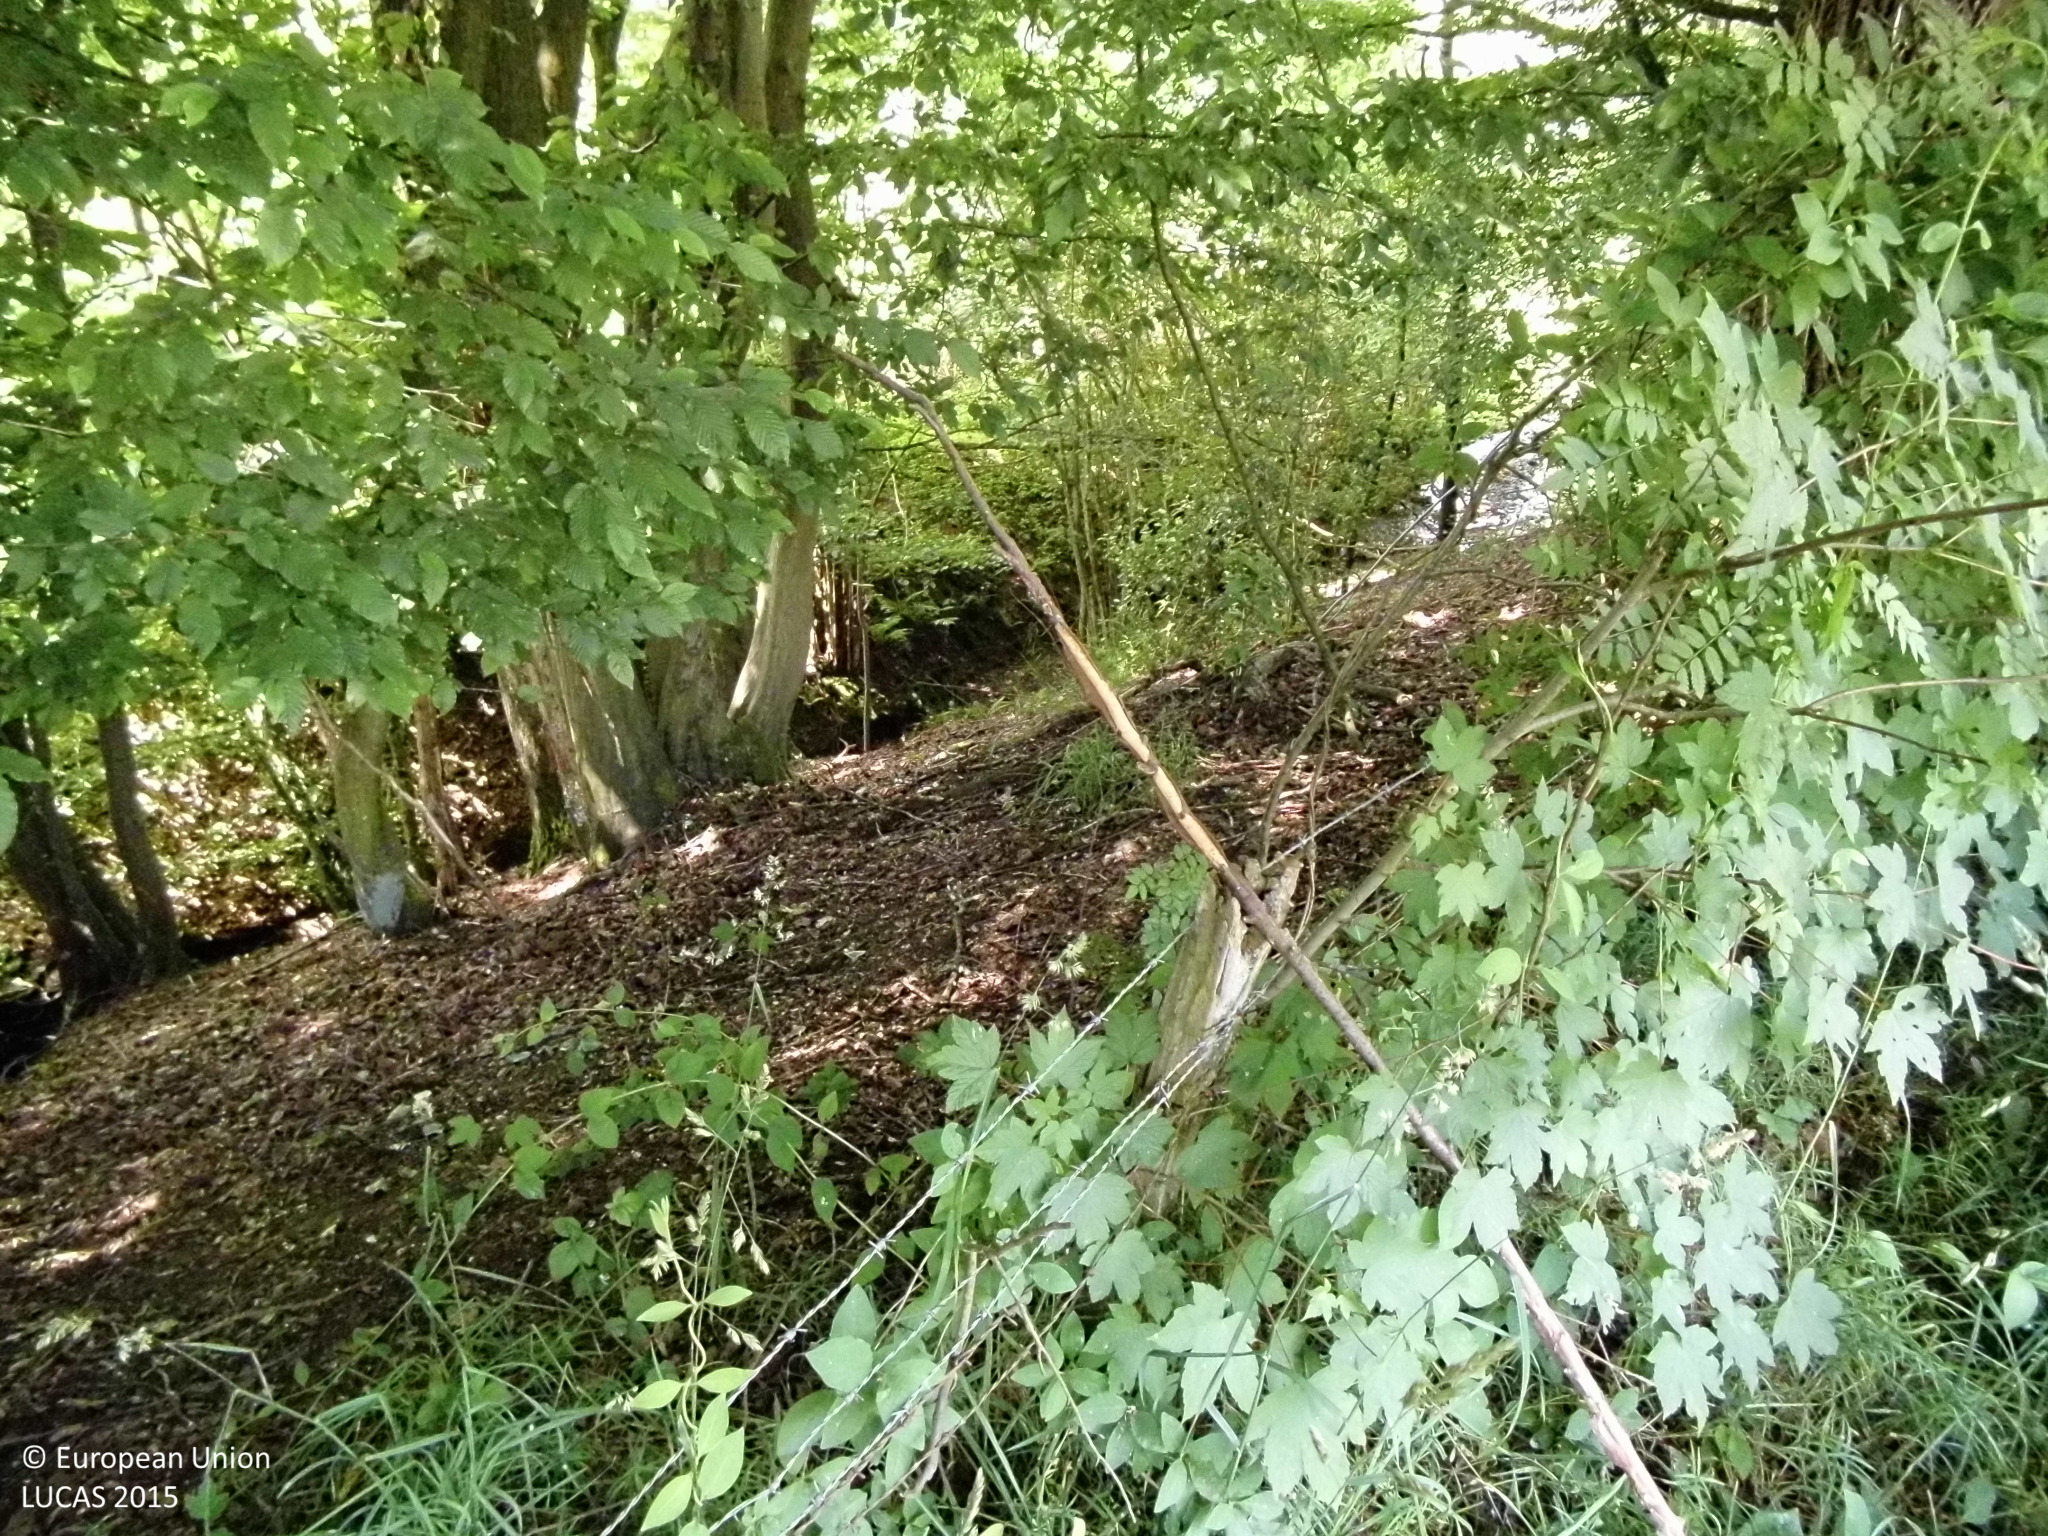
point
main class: Woodland
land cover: Broadleaved woodland
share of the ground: > 75 %
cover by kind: broadleaved forest trees 100 %
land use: Semi-natural and natural areas not in use
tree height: > 5 m
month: June
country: DE
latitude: 50.9826
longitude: 7.4220
